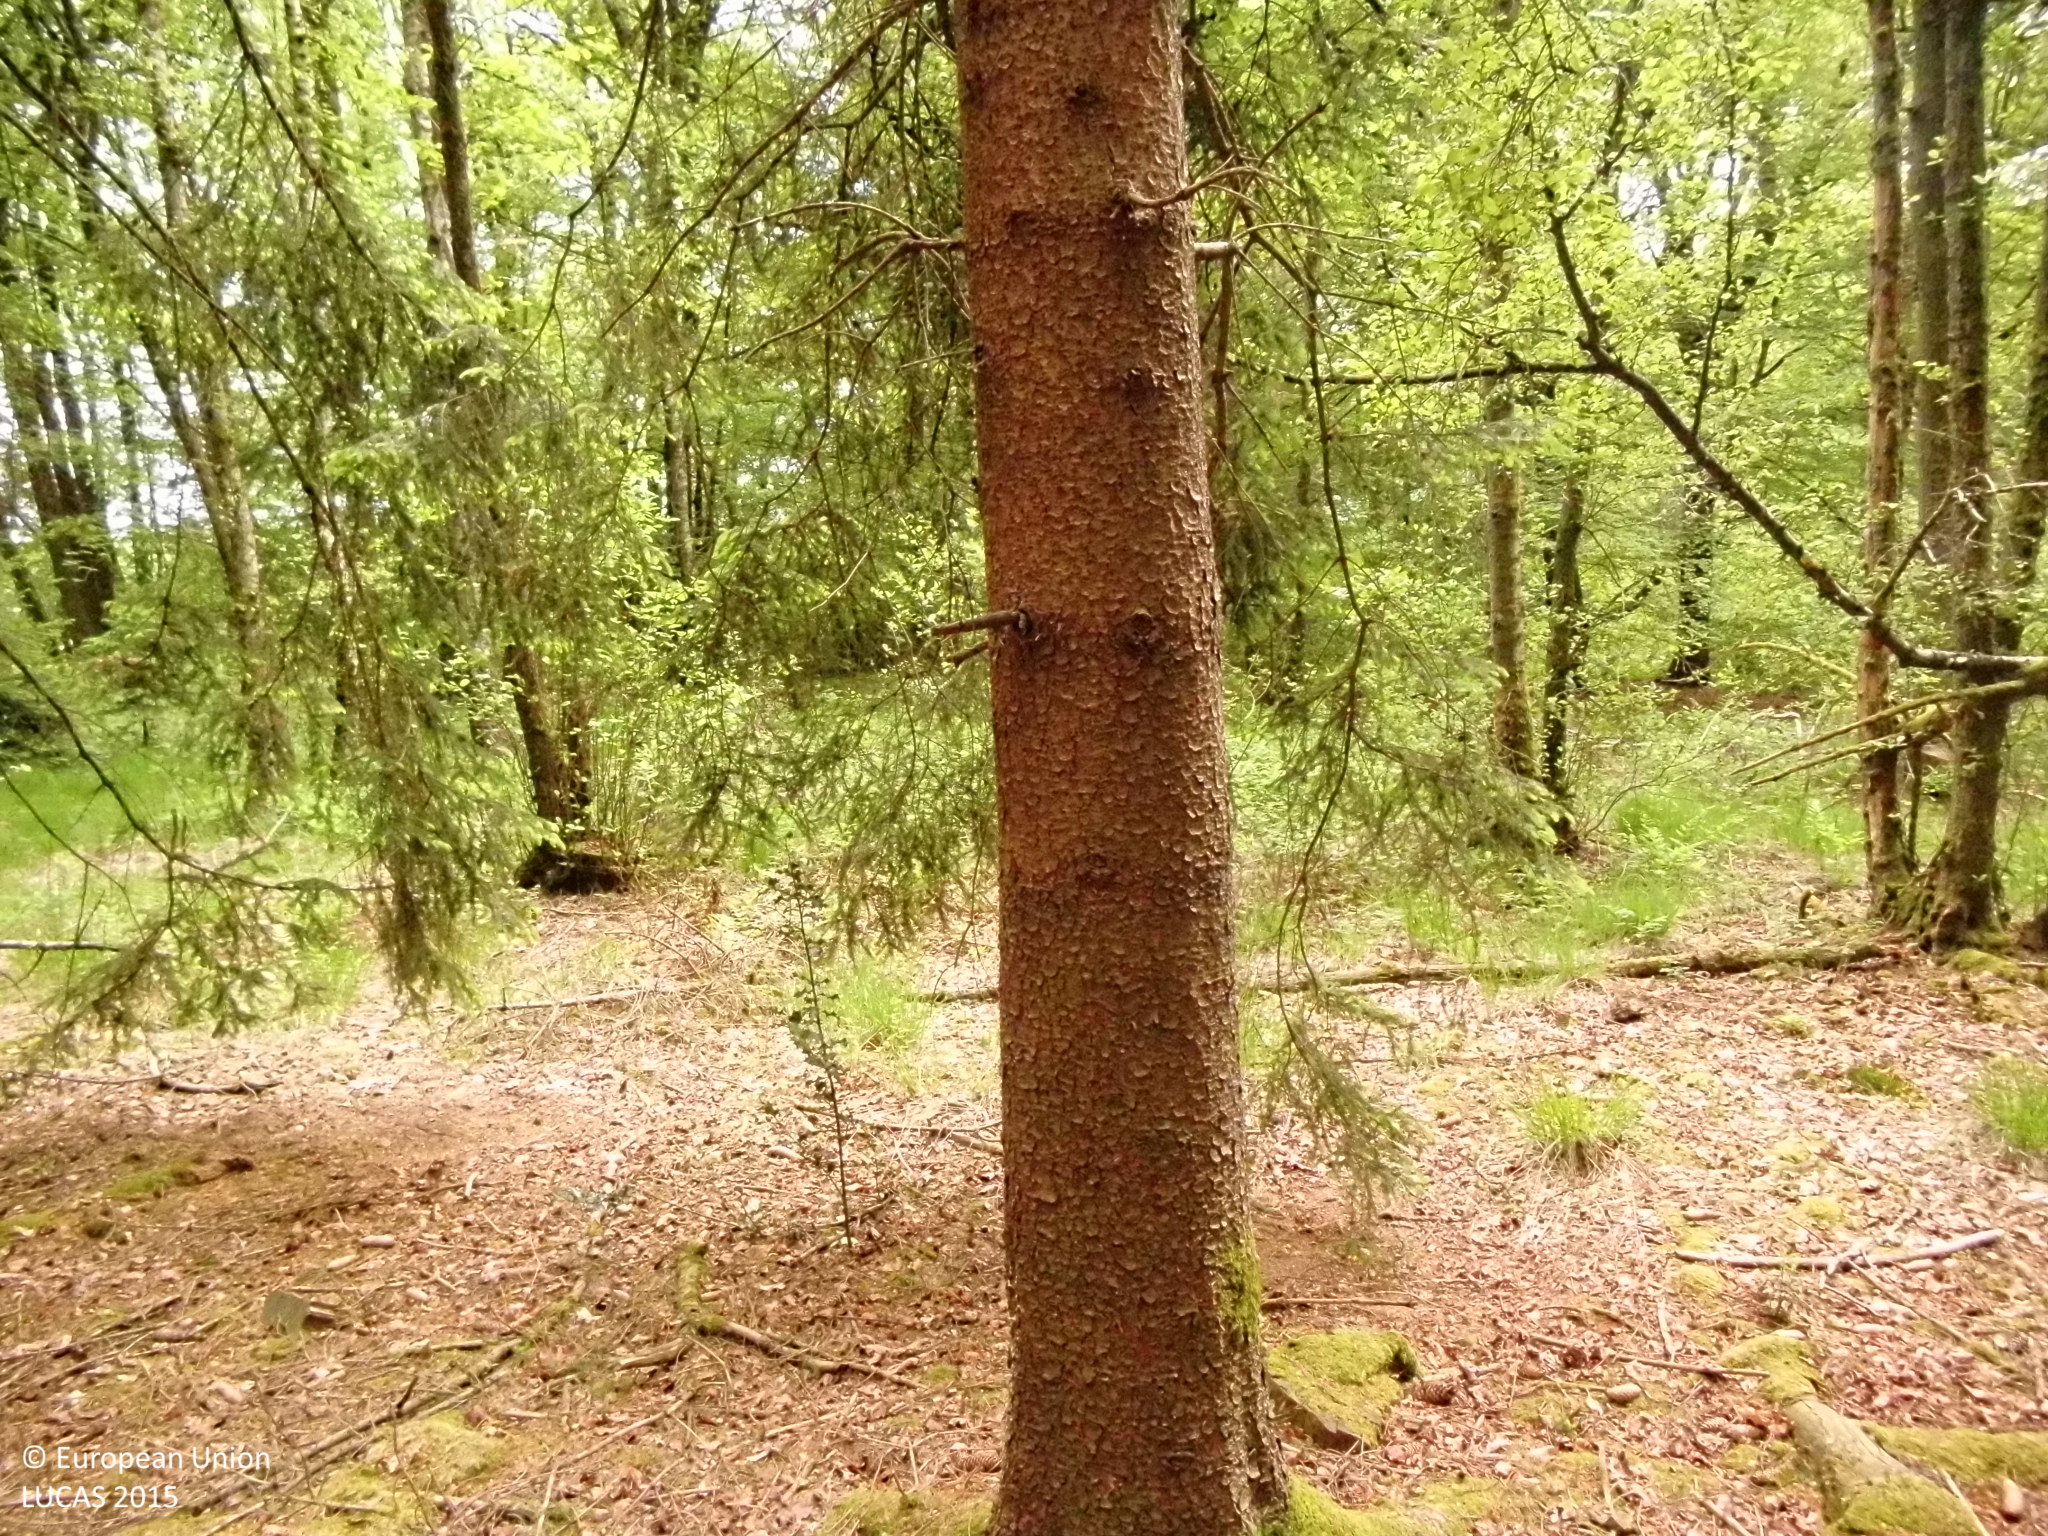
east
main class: Woodland
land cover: Spruce dominated coniferous woodland
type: hemiboreal forest and nemoral coniferous forest and mixed broadleaved-coniferous forest
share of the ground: > 75 %
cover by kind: coniferous forest trees 80 %, unconsolidated bare surface 15 %, herbaceous plants 5 %
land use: Forestry
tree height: > 5 m
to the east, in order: Spruce dominated coniferous woodland; Broadleaved woodland; Tracks; Grass margins; Fences; Grassland without tree/shrub cover; Fences; Grass margins; Tracks; Broadleaved woodland; Grassland without tree/shrub cover; Fences; Single bushes/trees; Fences; Electric lines; Grassland without tree/shrub cover; Fences; Grass margins; Paved roads, cycling and walking lanes; Grassland without tree/shrub cover
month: May
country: DE
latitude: 50.9306
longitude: 7.5103
